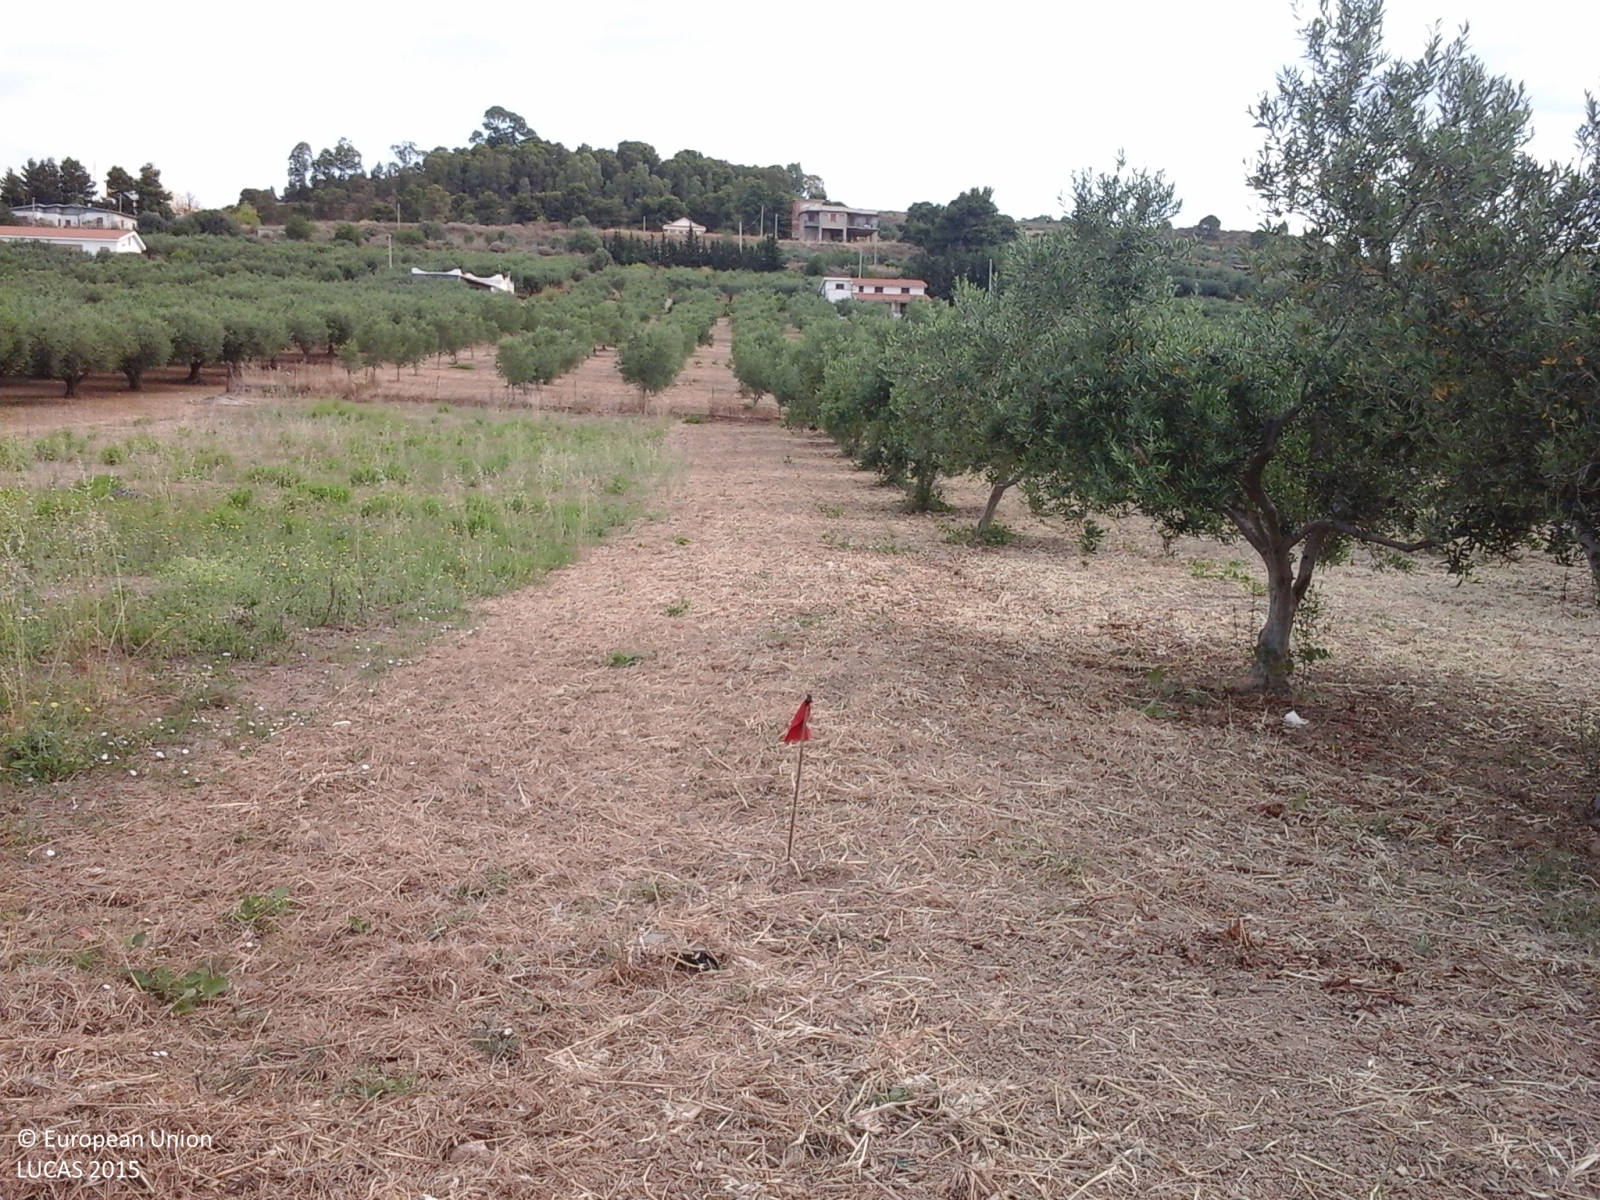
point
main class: Cropland
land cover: Olive groves
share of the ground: 25 - 50 %
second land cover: Grassland without tree/shrub cover
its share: > 75 %
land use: Agriculture (excluding fallow land and kitchen gardens)
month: June
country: IT
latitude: 37.4947
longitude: 13.1765
